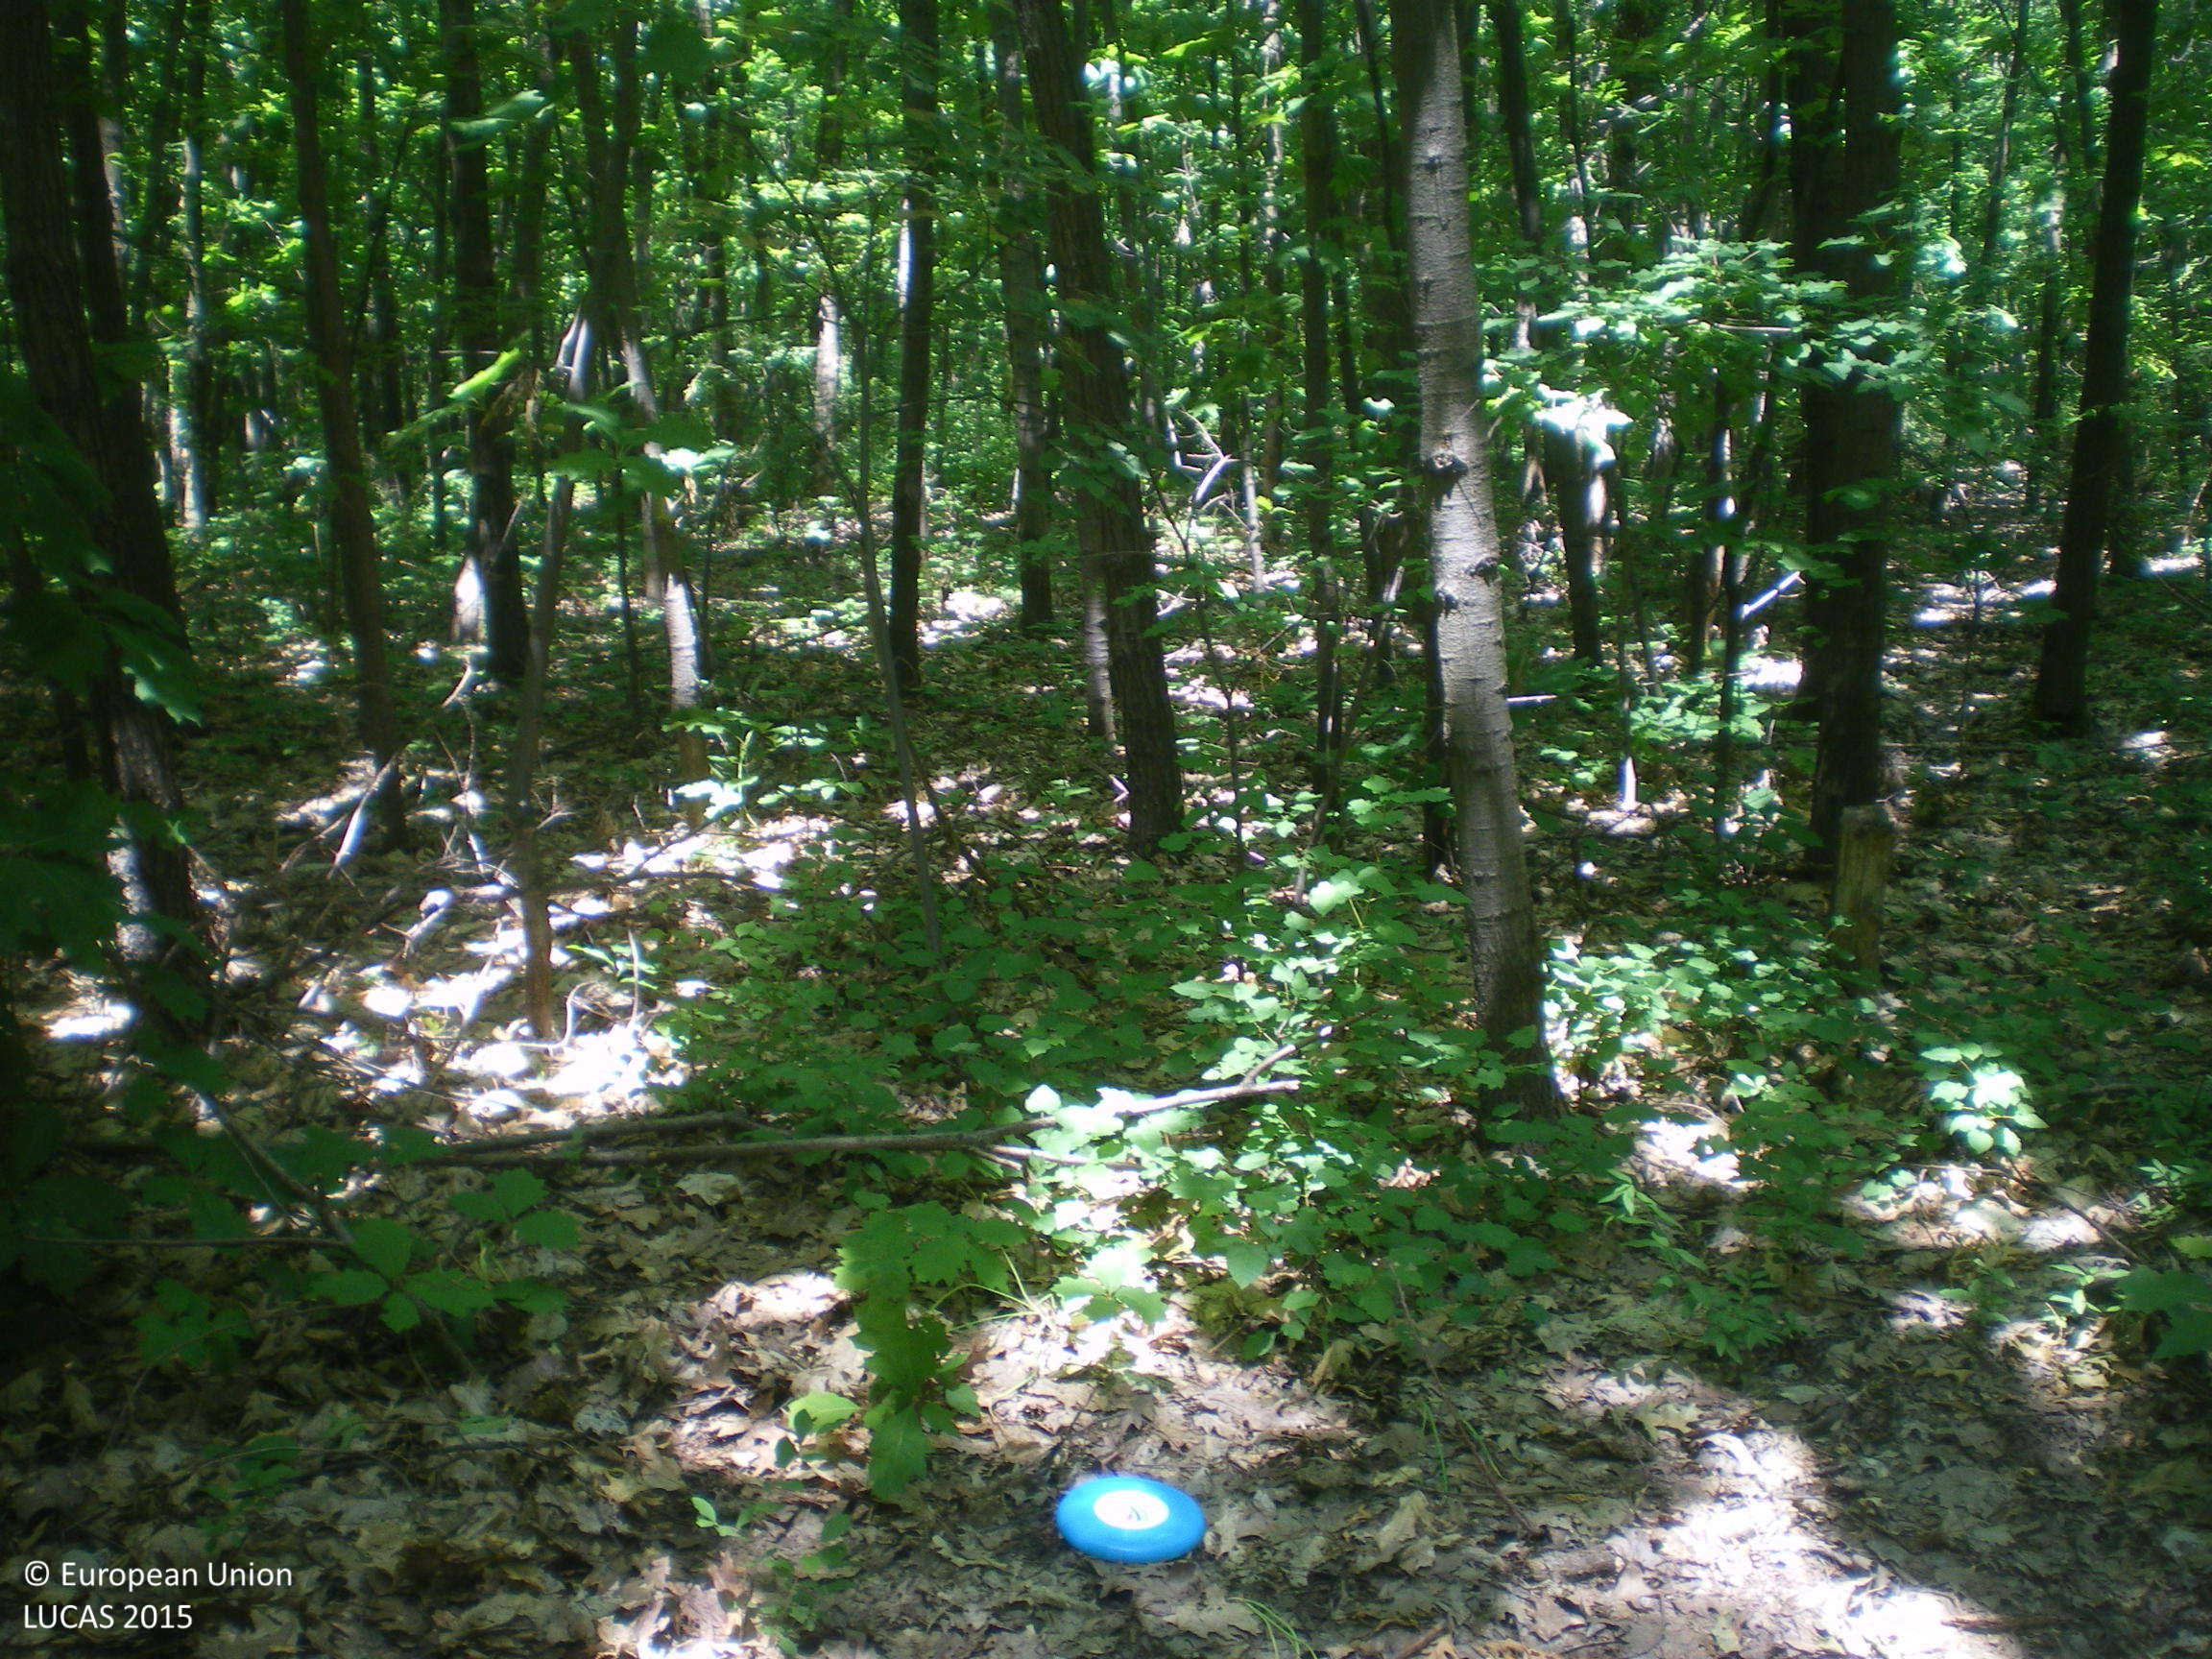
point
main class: Woodland
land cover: Broadleaved woodland
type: mesophytic deciduous forest
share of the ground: > 75 %
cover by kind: broadleaved forest trees 95 %, herbaceous plants 5 %
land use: Forestry
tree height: > 5 m
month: June
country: BG
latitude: 42.2268
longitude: 25.1194
